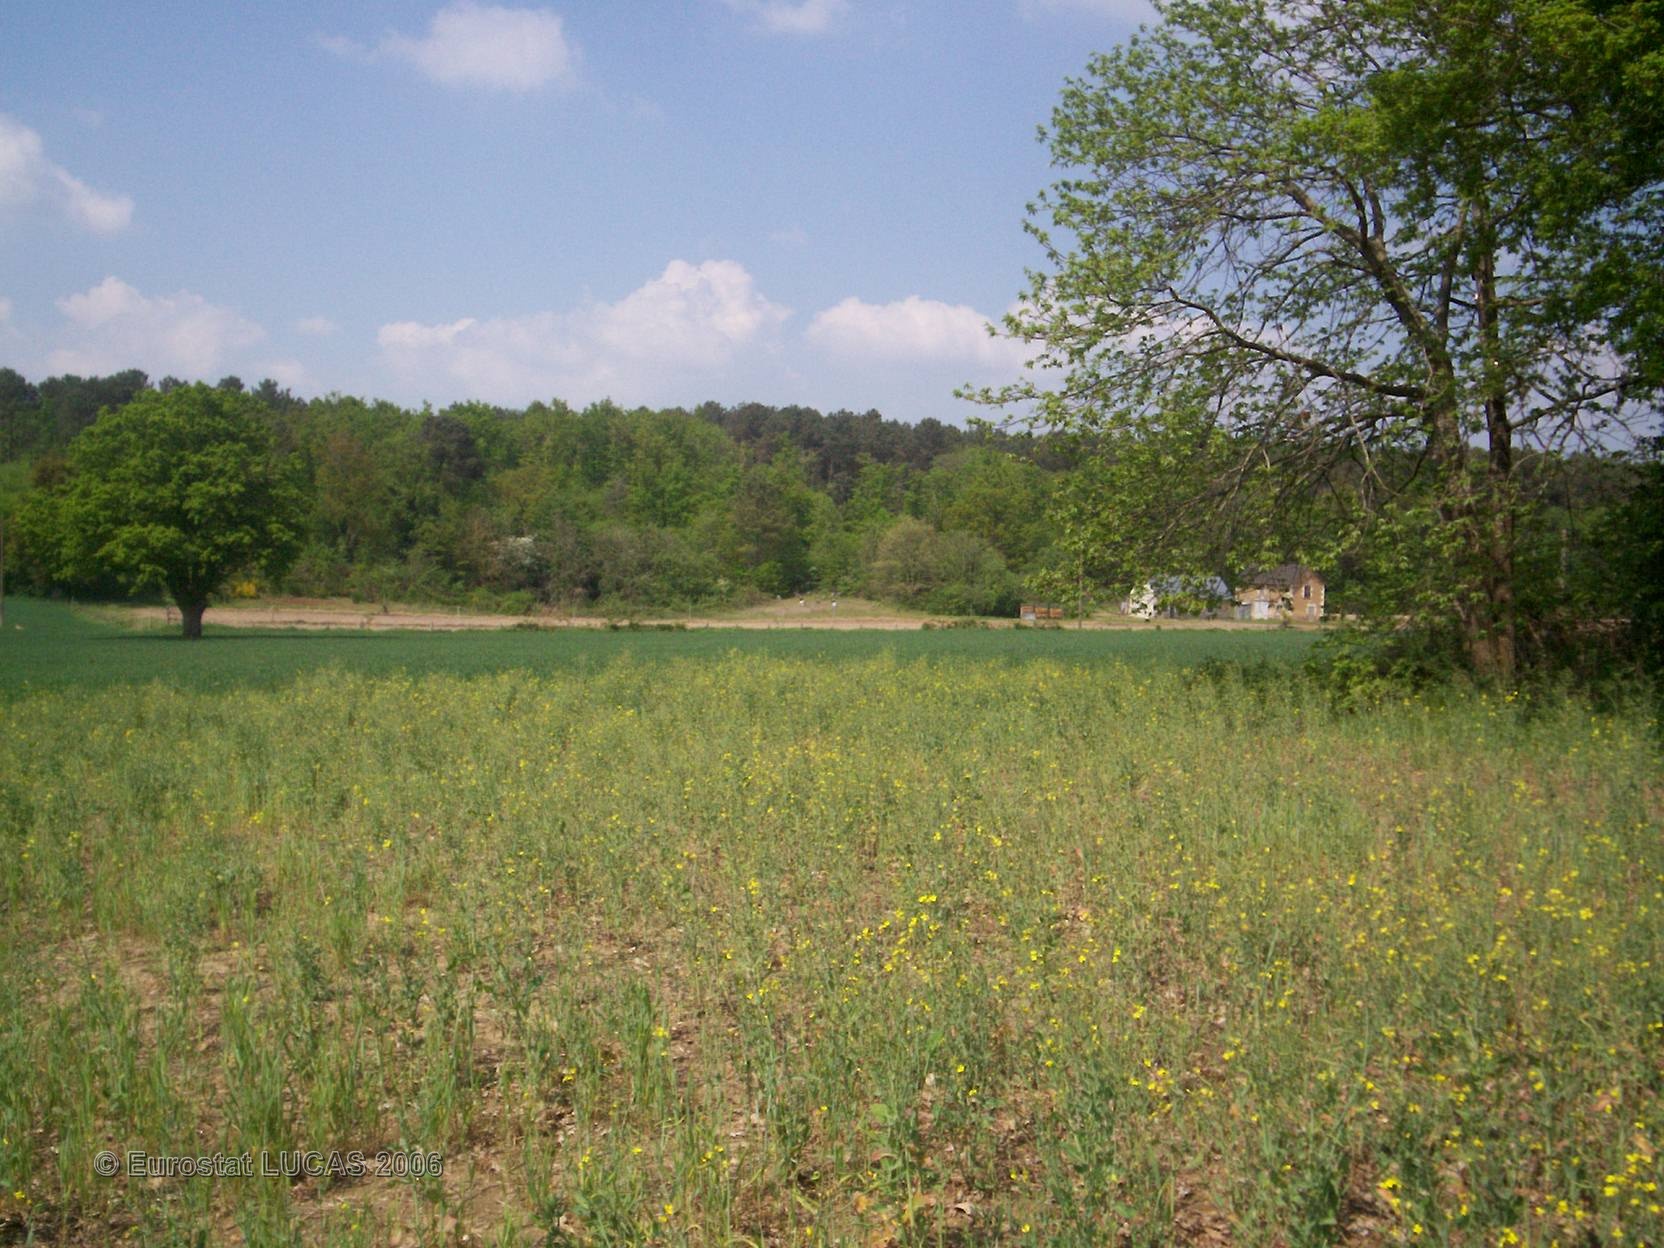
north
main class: Cropland
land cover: Rape and turnip rape
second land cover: Common wheat
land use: Agriculture (excluding fallow land and kitchen gardens)
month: May
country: FR
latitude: 47.6758
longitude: 0.1851
